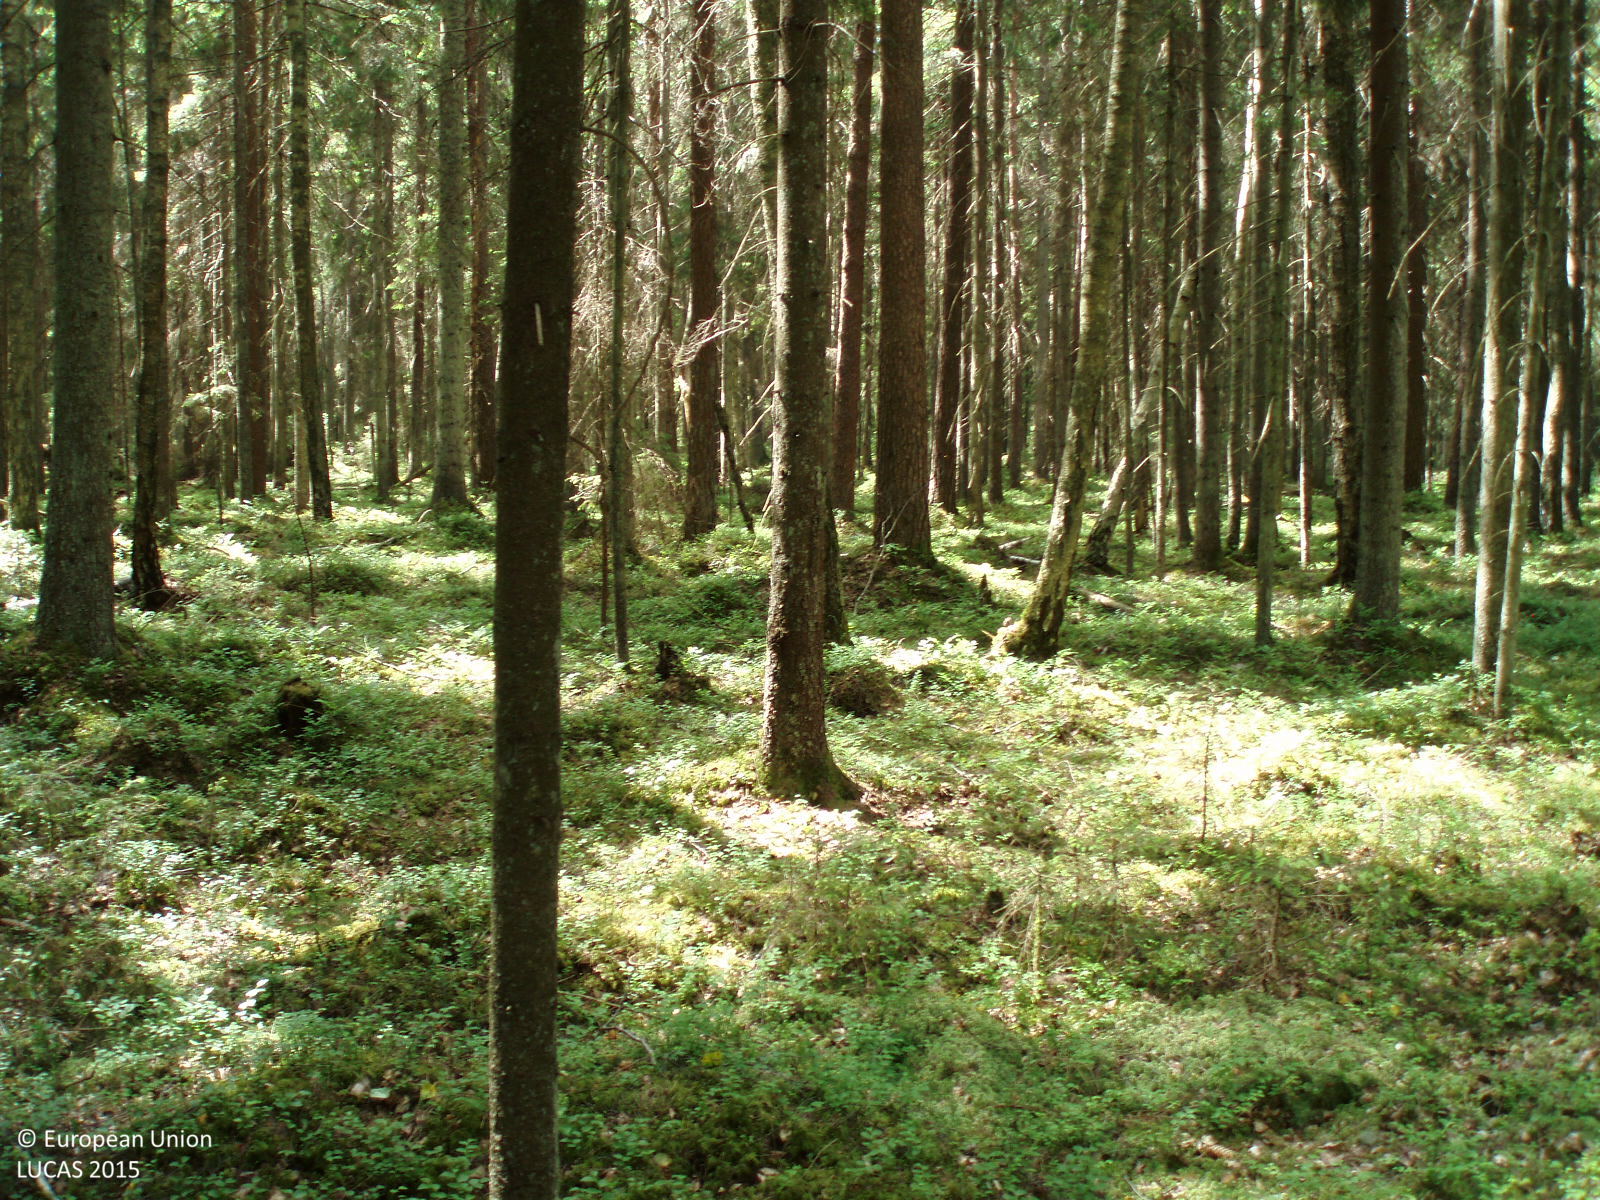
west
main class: Woodland
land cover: Spruce dominated coniferous woodland
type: hemiboreal forest and nemoral coniferous forest and mixed broadleaved-coniferous forest
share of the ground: > 75 %
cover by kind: coniferous forest trees 60 %, broadleaved forest trees 20 %, herbaceous plants 10 %, lichens and mosses 10 %
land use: Forestry
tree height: > 5 m
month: June
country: LT
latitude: 55.1570
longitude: 22.4760
